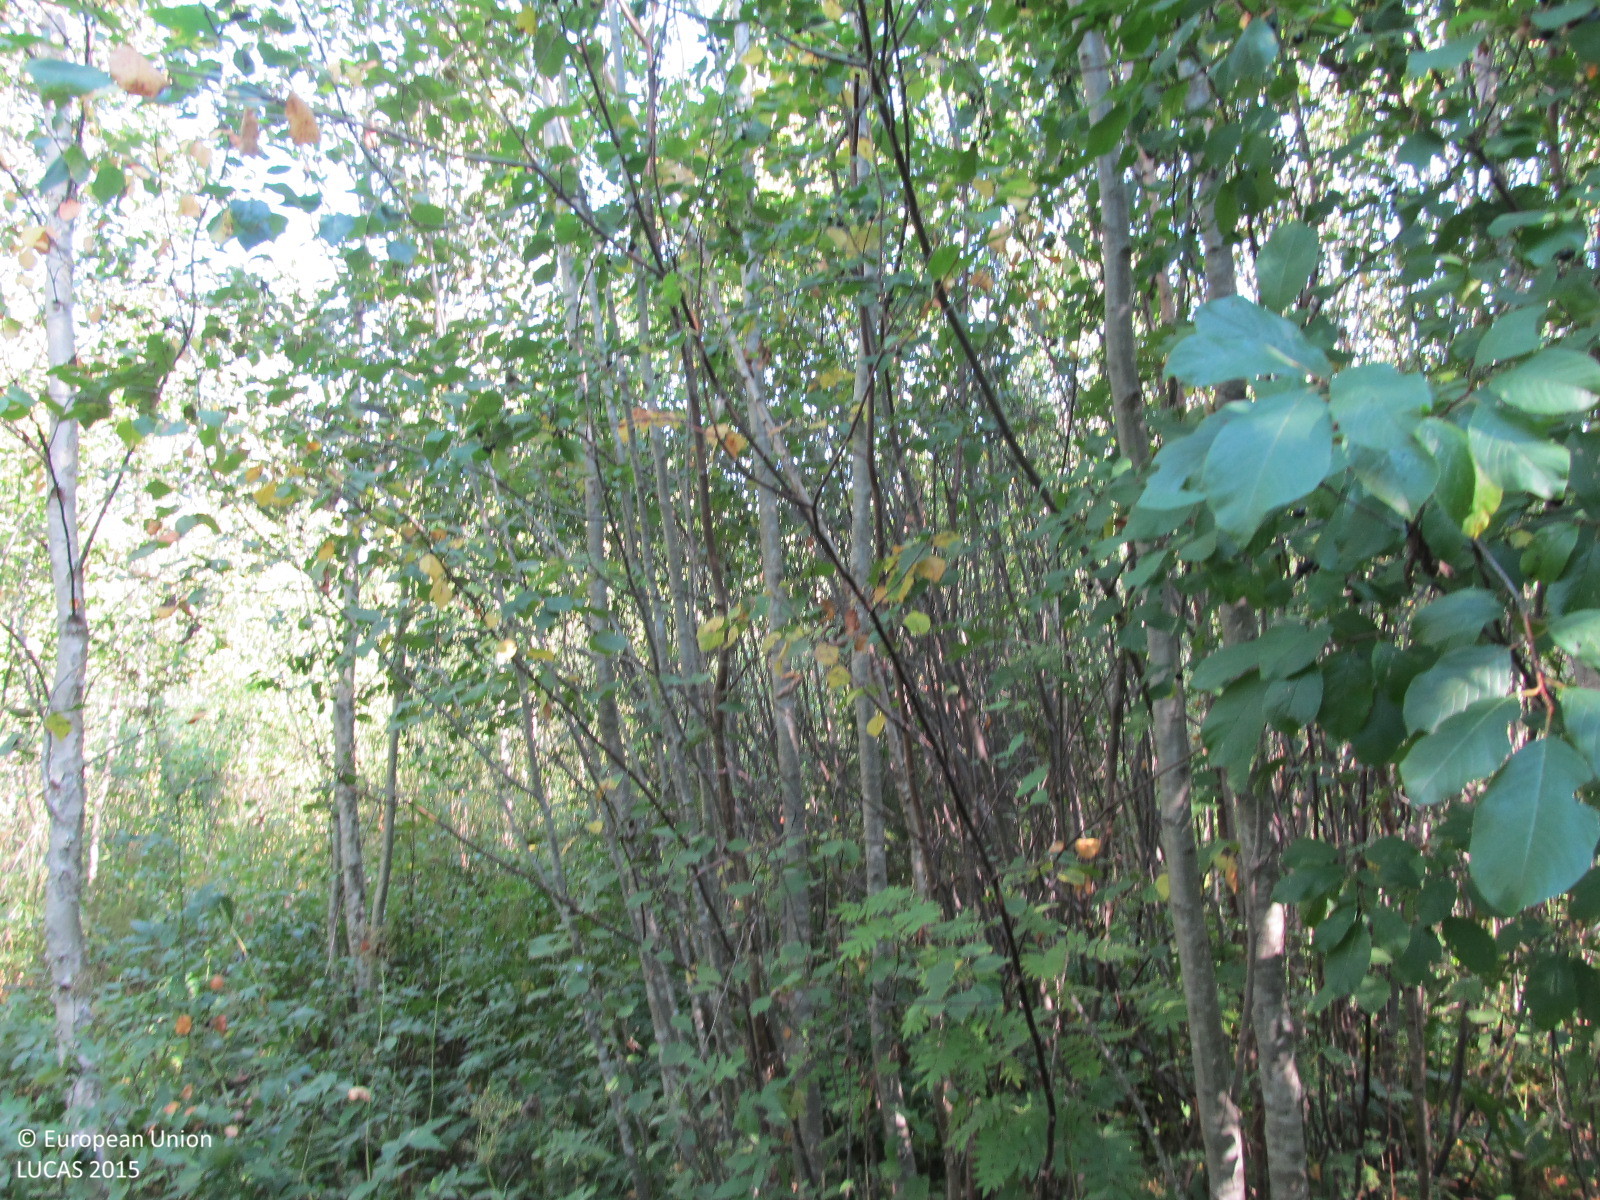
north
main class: Woodland
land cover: Broadleaved woodland
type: non-riverine alder, birch or aspen forest
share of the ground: > 75 %
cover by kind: broadleaved forest trees 80 %, herbaceous plants 20 %
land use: Forestry
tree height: < 5 m
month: August
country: LT
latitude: 55.7300
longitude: 23.1124
